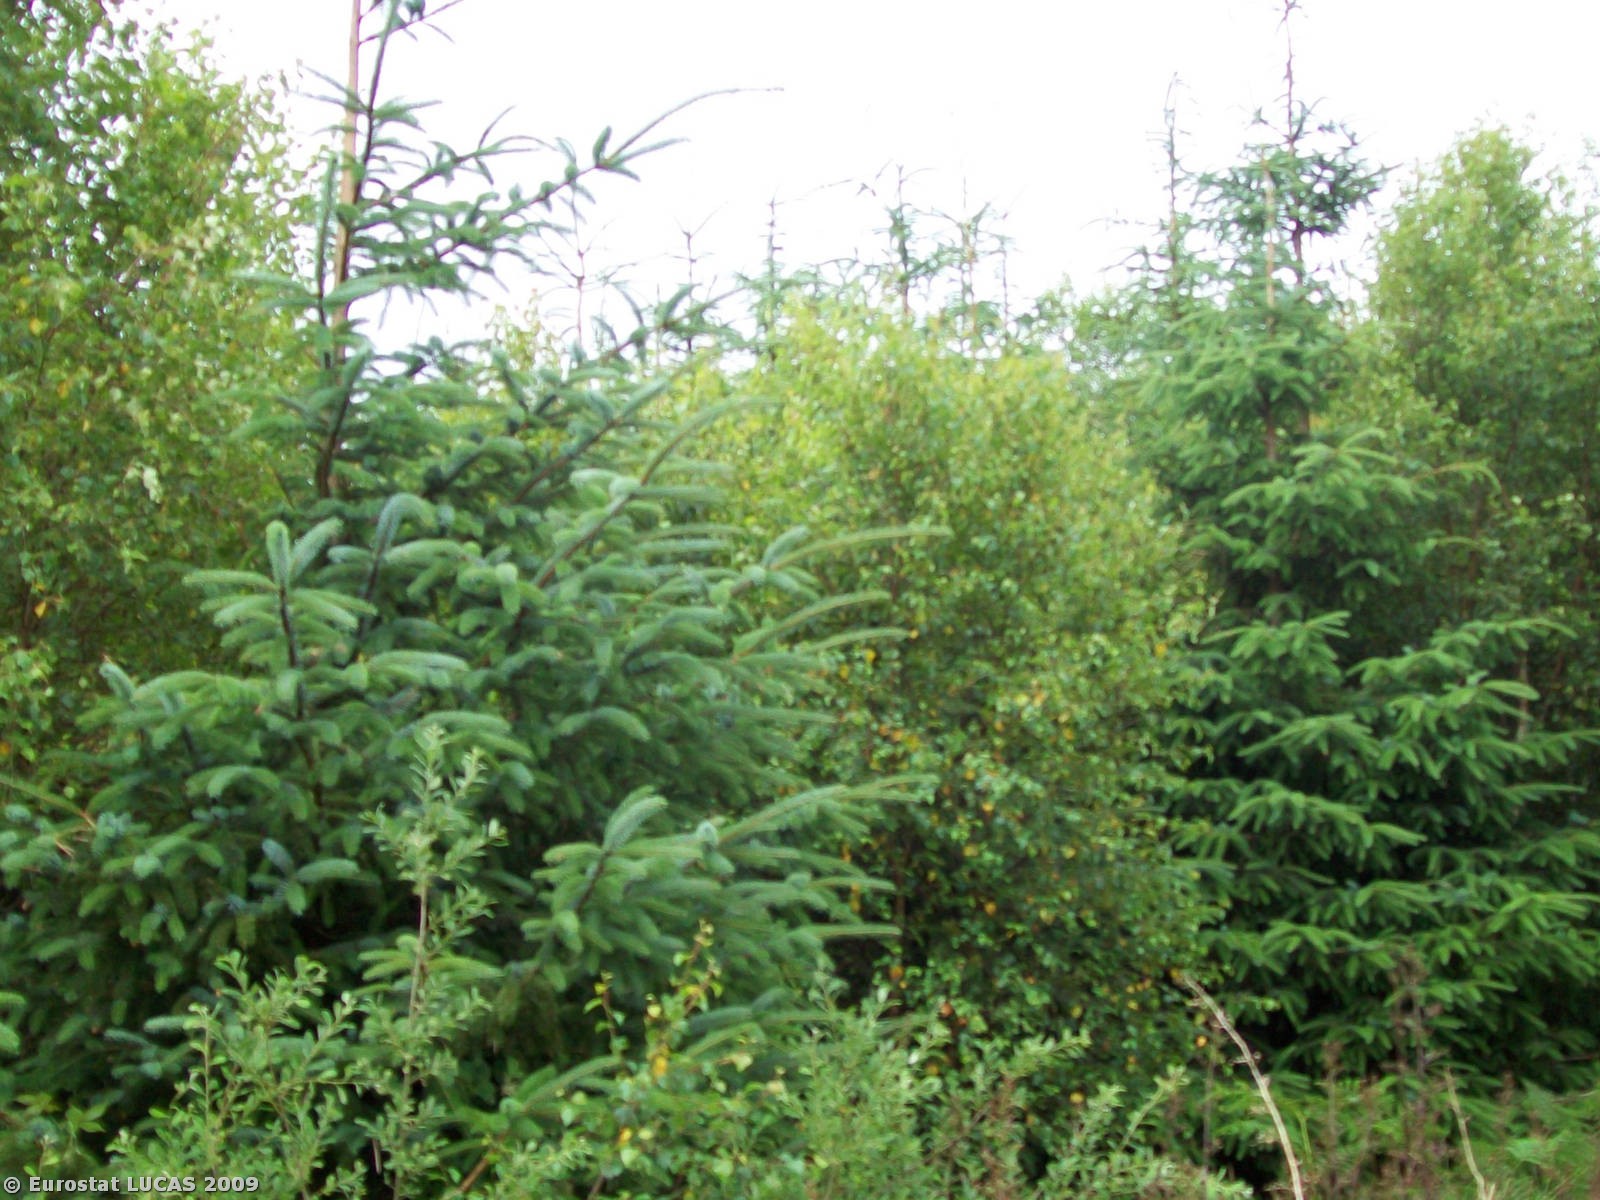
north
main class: Woodland
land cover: Mixed woodland
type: hemiboreal forest and nemoral coniferous forest and mixed broadleaved-coniferous forest
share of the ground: > 75 %
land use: Forestry
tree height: > 5 m
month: July
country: IE
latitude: 53.6600
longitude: -8.9598
